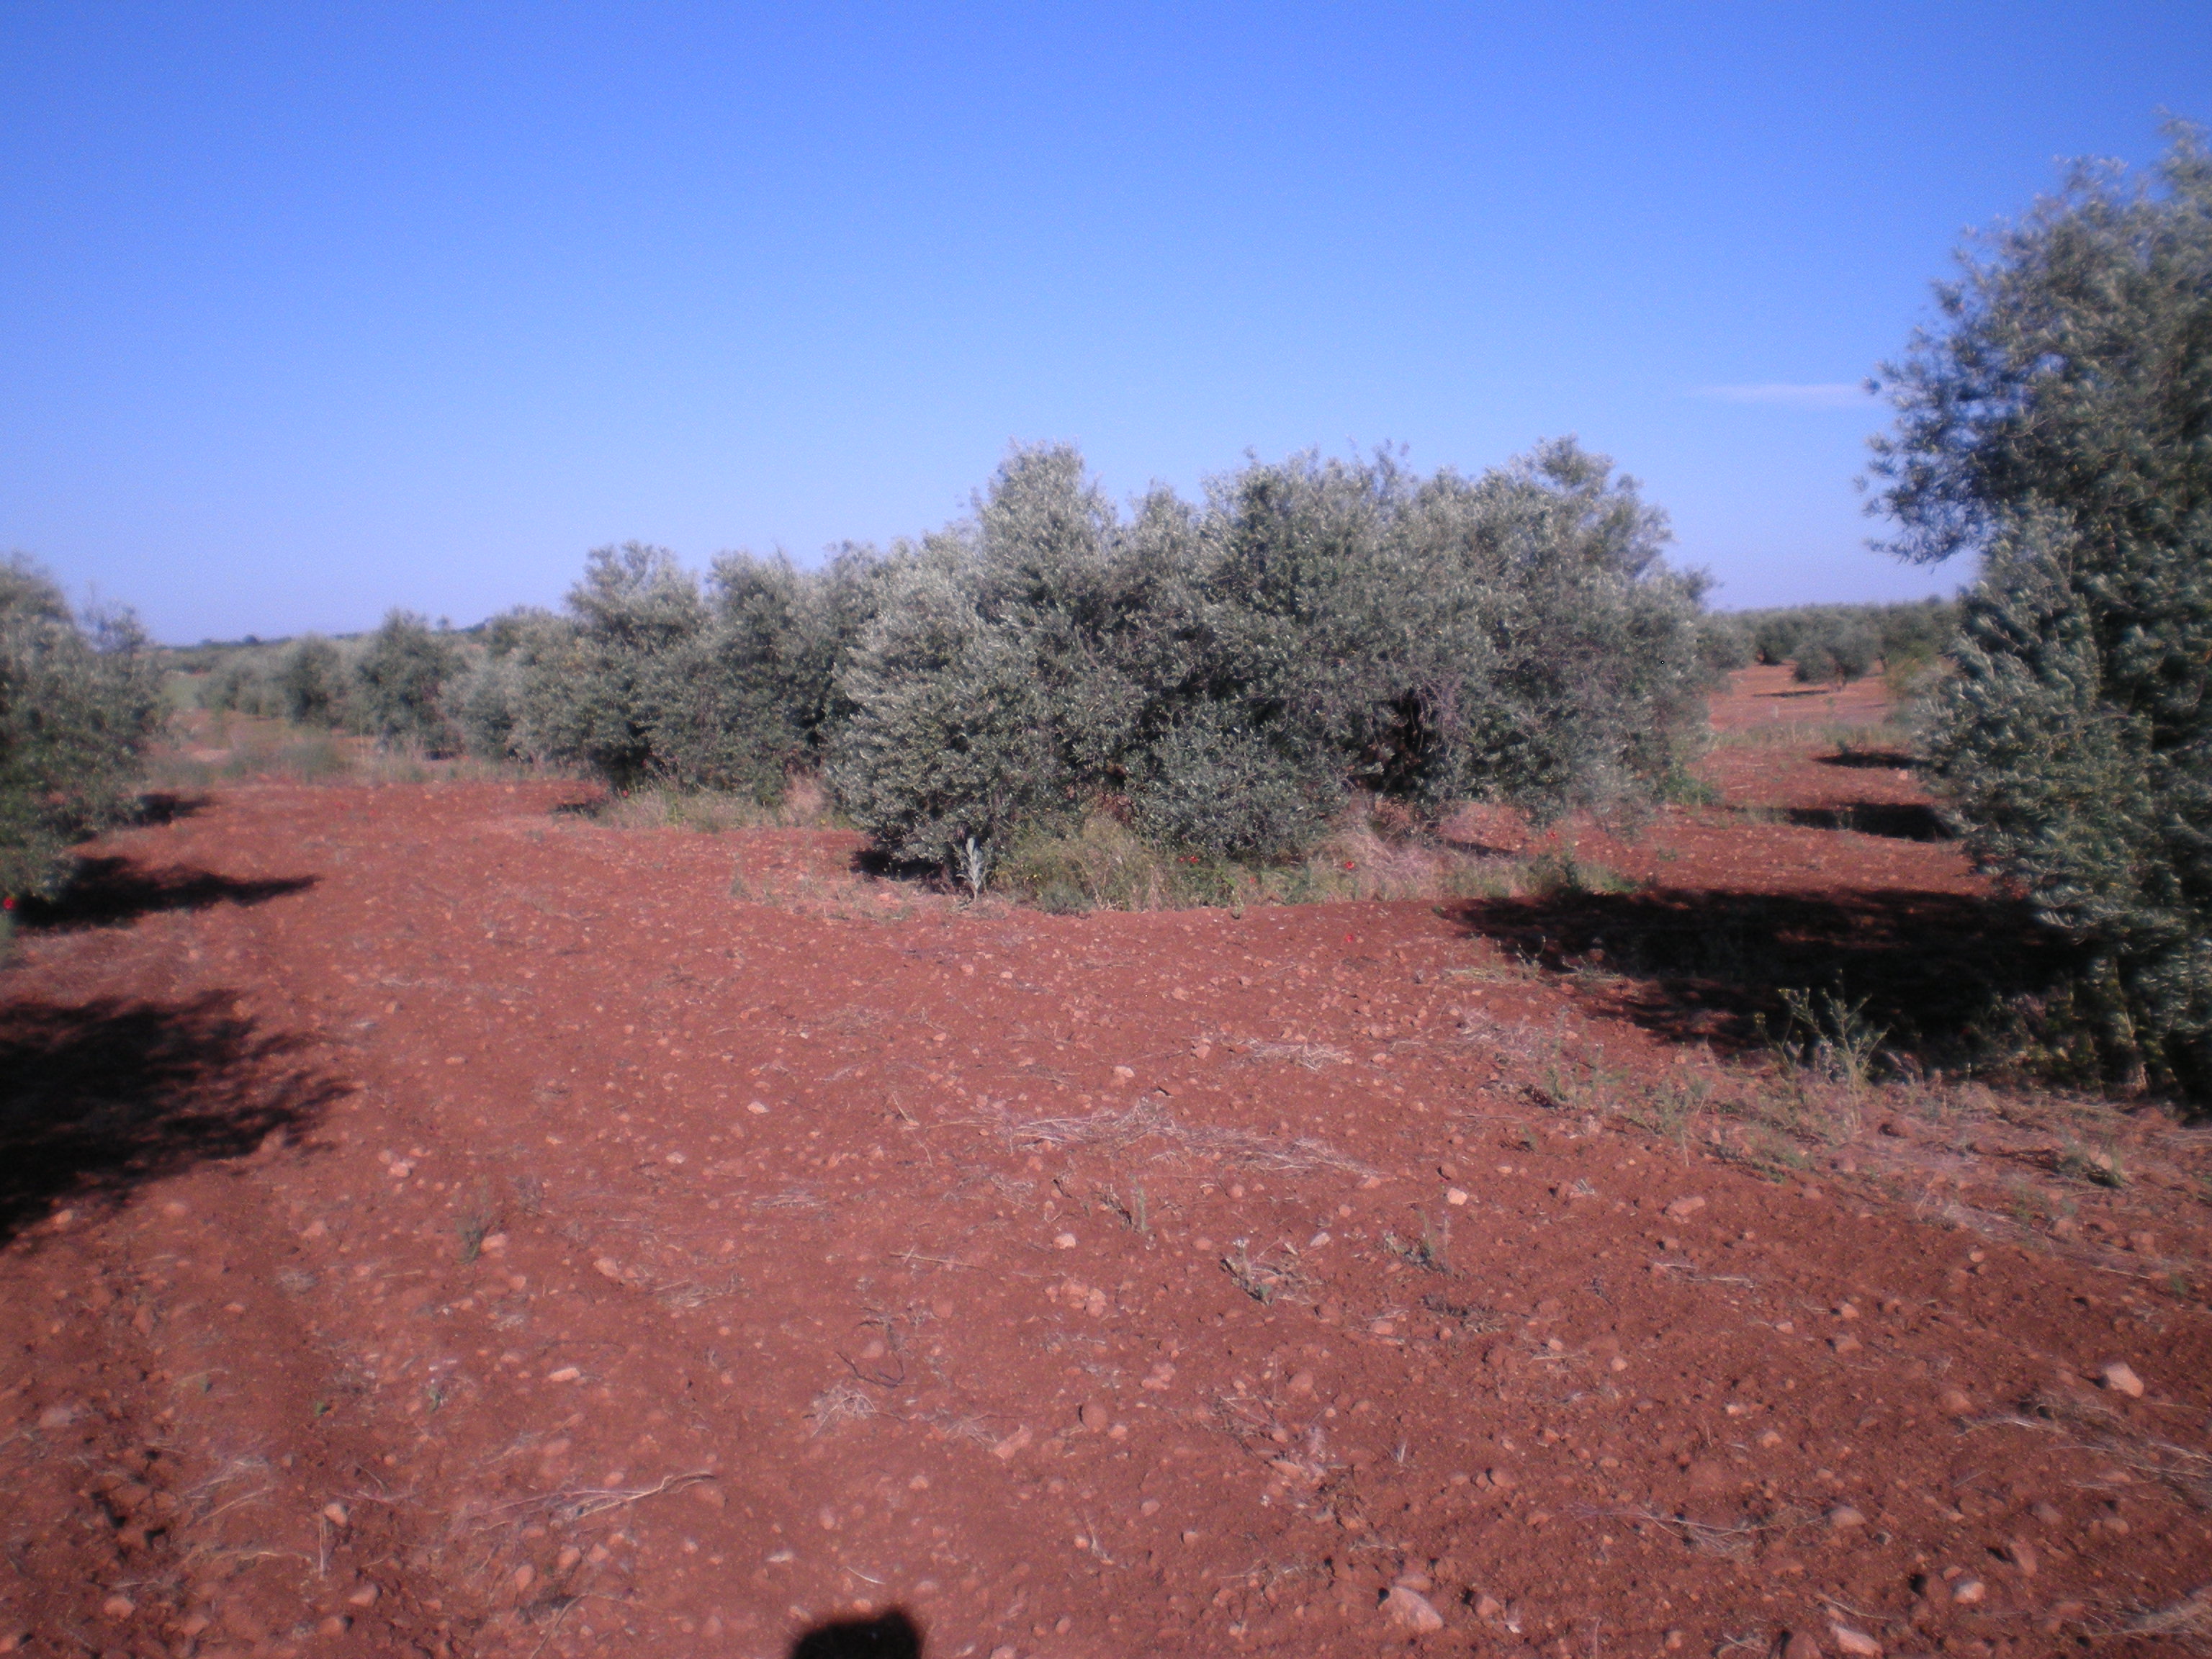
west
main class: Cropland
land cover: Olive groves
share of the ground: 10 - 25 %
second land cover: Other bare soil
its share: > 75 %
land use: Agriculture (excluding fallow land and kitchen gardens)
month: May
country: ES
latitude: 38.6746
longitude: -2.9362
